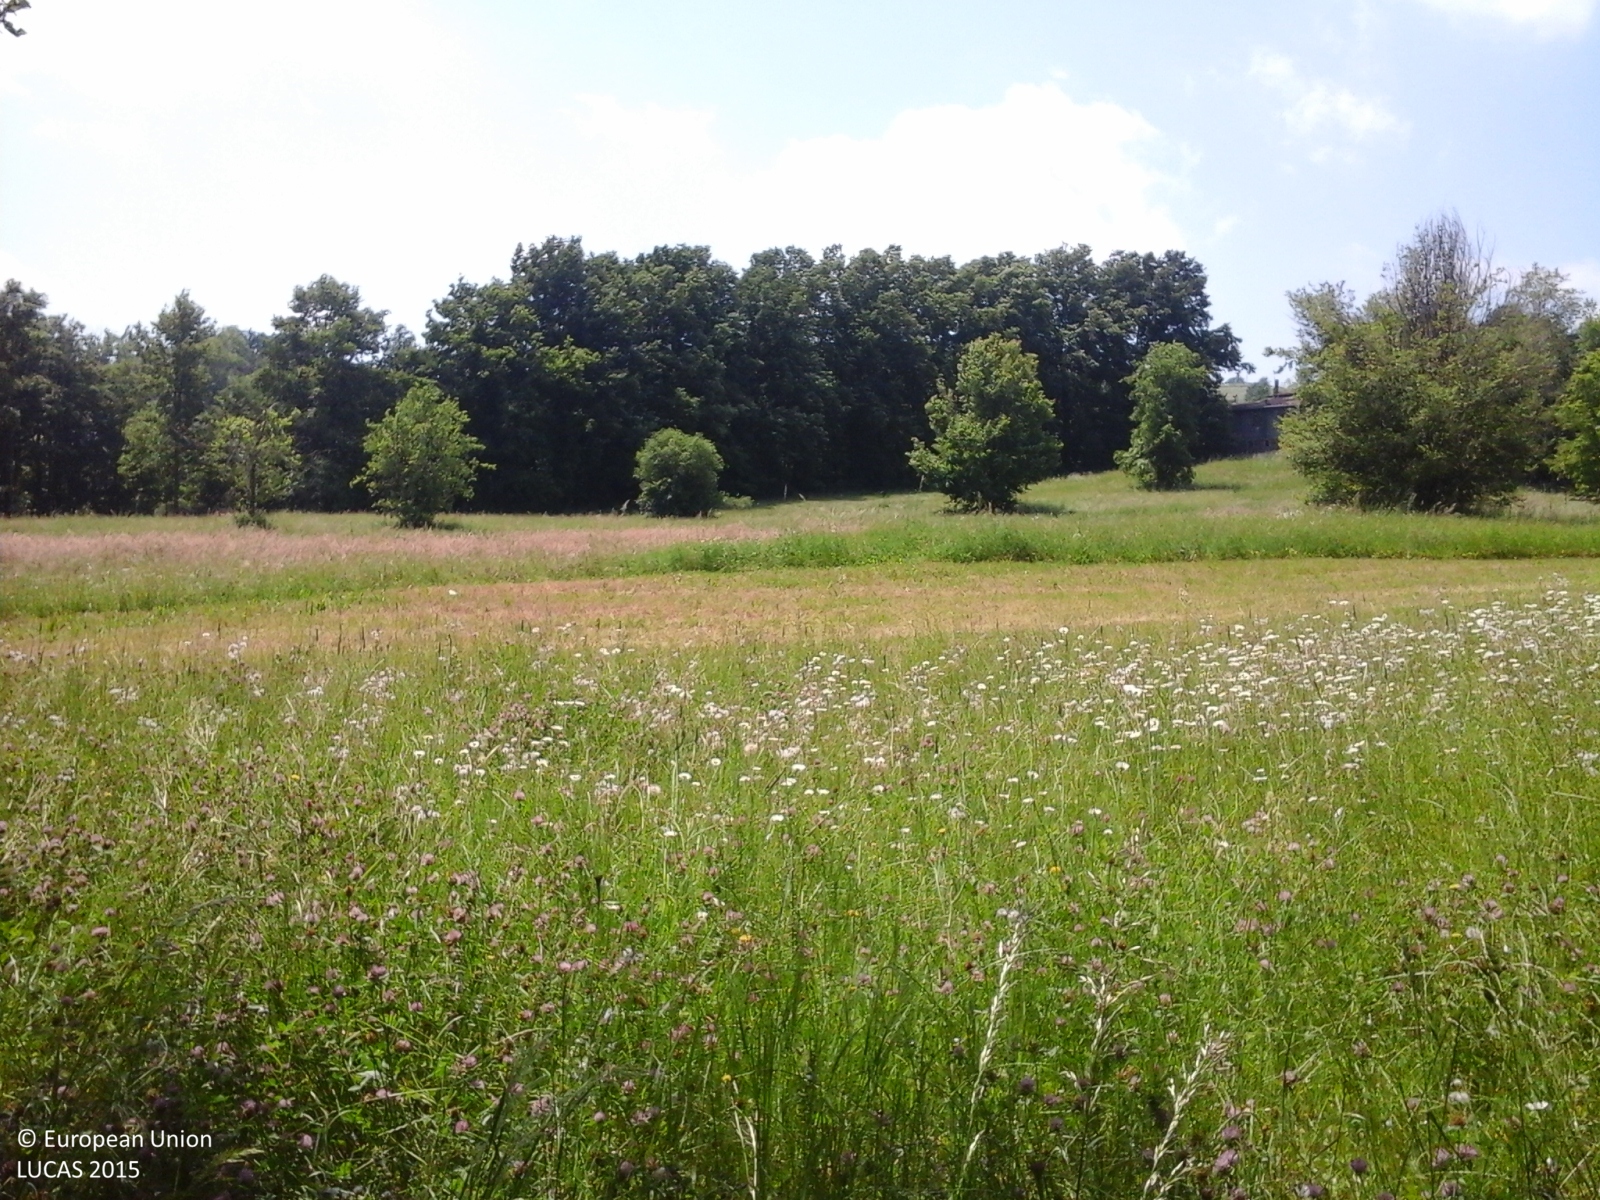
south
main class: Woodland
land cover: Broadleaved woodland
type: thermophilous deciduous forest
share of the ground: > 75 %
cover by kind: broadleaved forest trees 100 %
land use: Forestry
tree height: > 5 m
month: May
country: IT
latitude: 44.3832
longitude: 10.8391
